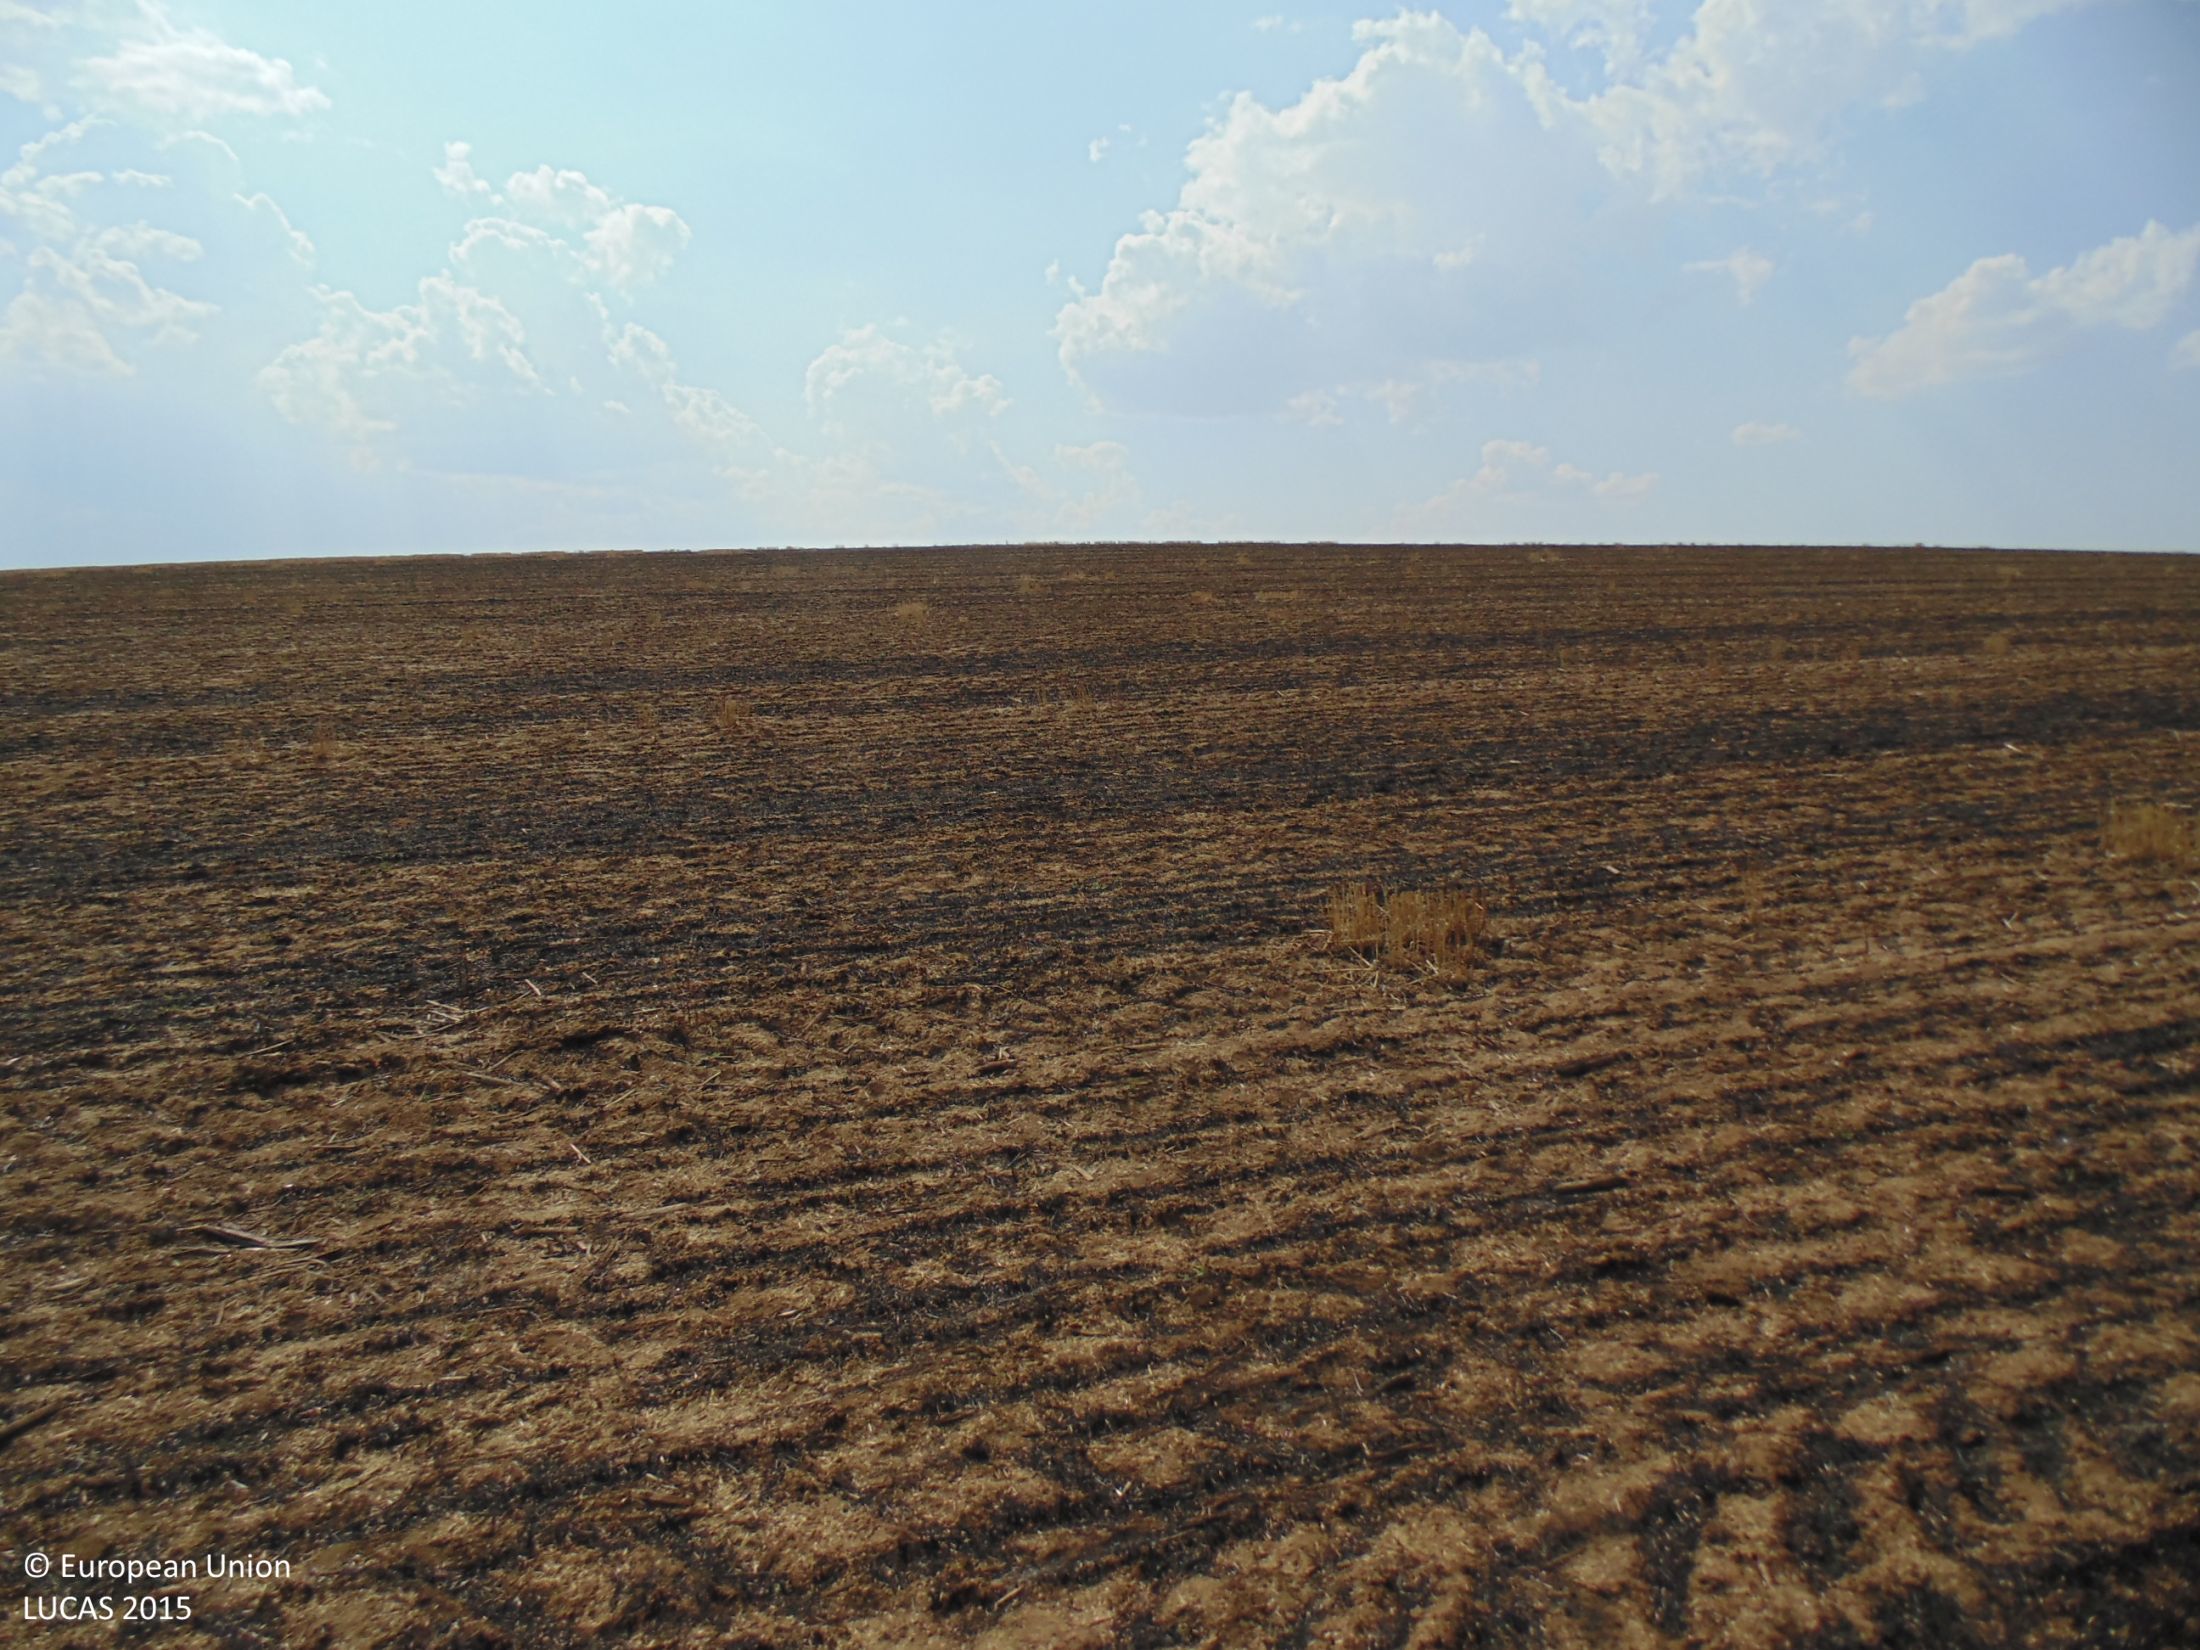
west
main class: Cropland
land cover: Common wheat
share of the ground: < 10 %
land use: Agriculture (excluding fallow land and kitchen gardens)
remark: Burnt area
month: August
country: BG
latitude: 43.9344
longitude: 27.6171
